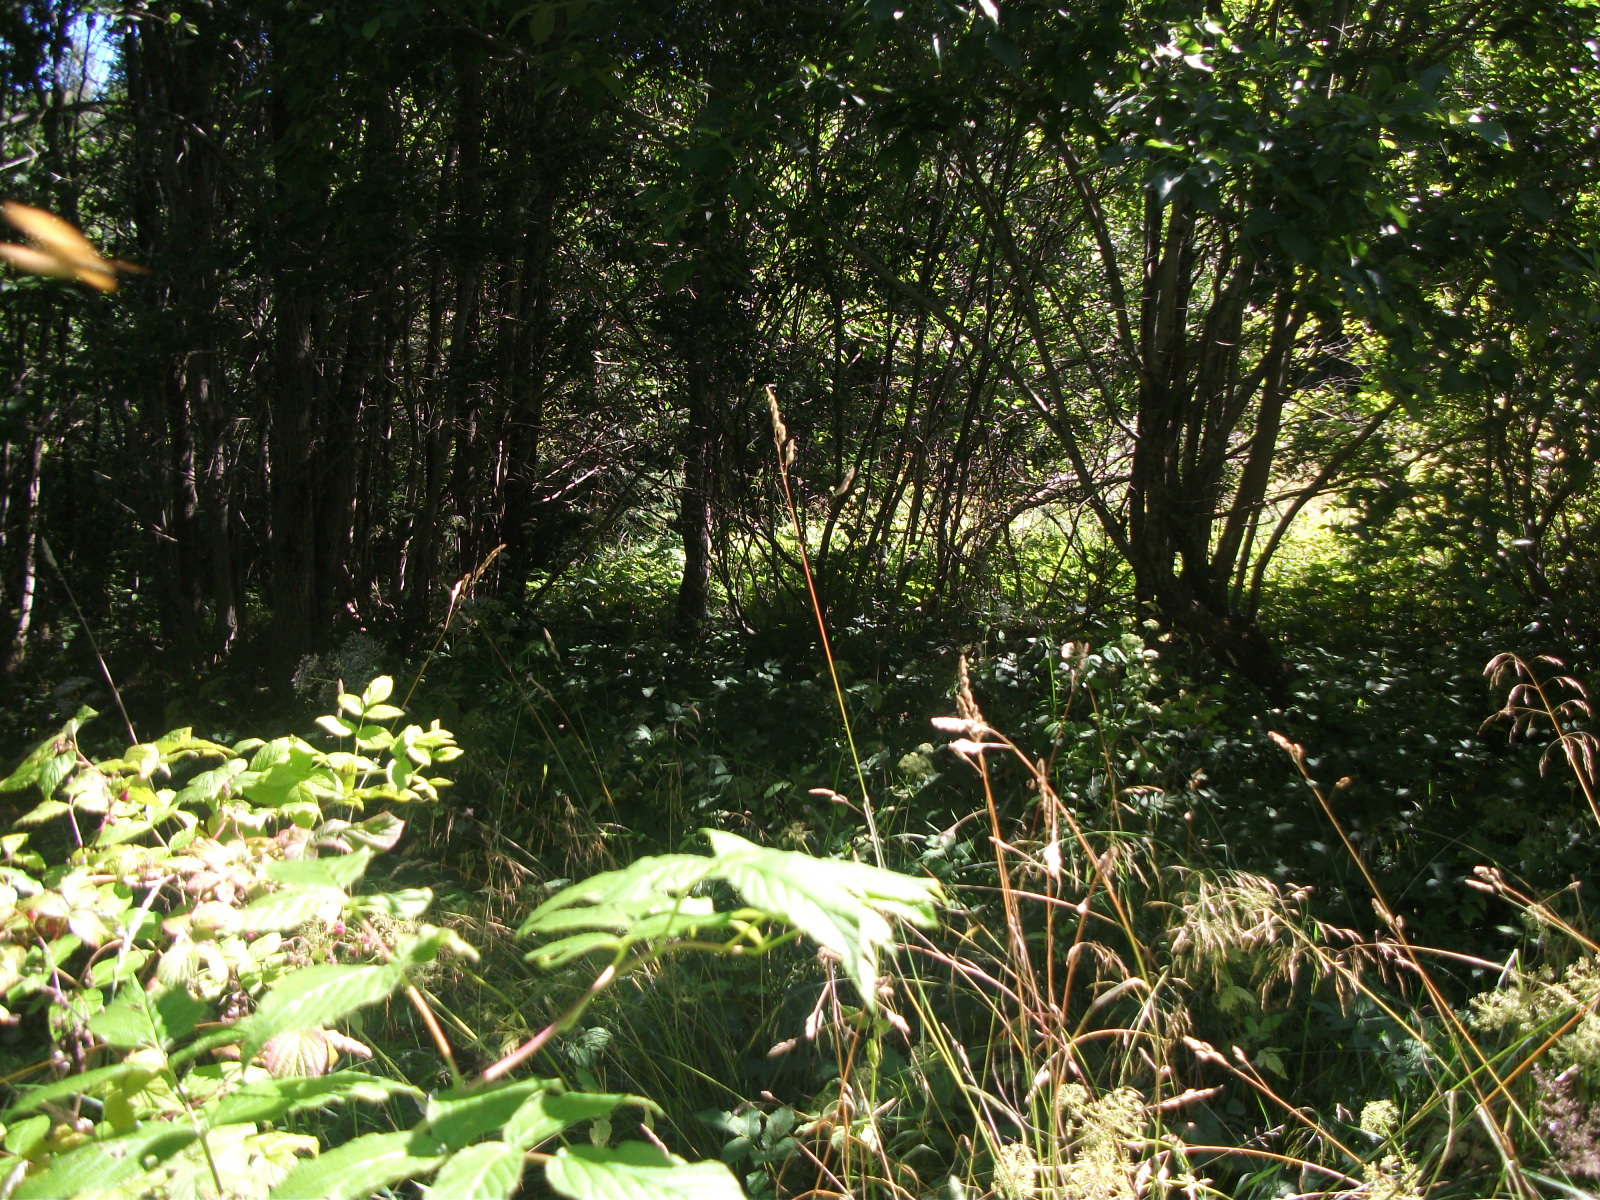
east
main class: Woodland
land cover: Broadleaved woodland
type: non-riverine alder, birch or aspen forest
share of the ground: > 75 %
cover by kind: broadleaved forest trees 75 %, shrubs 15 %, herbaceous plants 10 %
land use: Forestry
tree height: > 5 m
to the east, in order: Broadleaved woodland; Grassland with sparse tree/shrub cover; Broadleaved woodland; Fences; Grassland with sparse tree/shrub cover; Fences; Broadleaved woodland; Ditches and canals; Broadleaved woodland
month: August
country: LV
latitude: 57.0050
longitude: 26.4948
